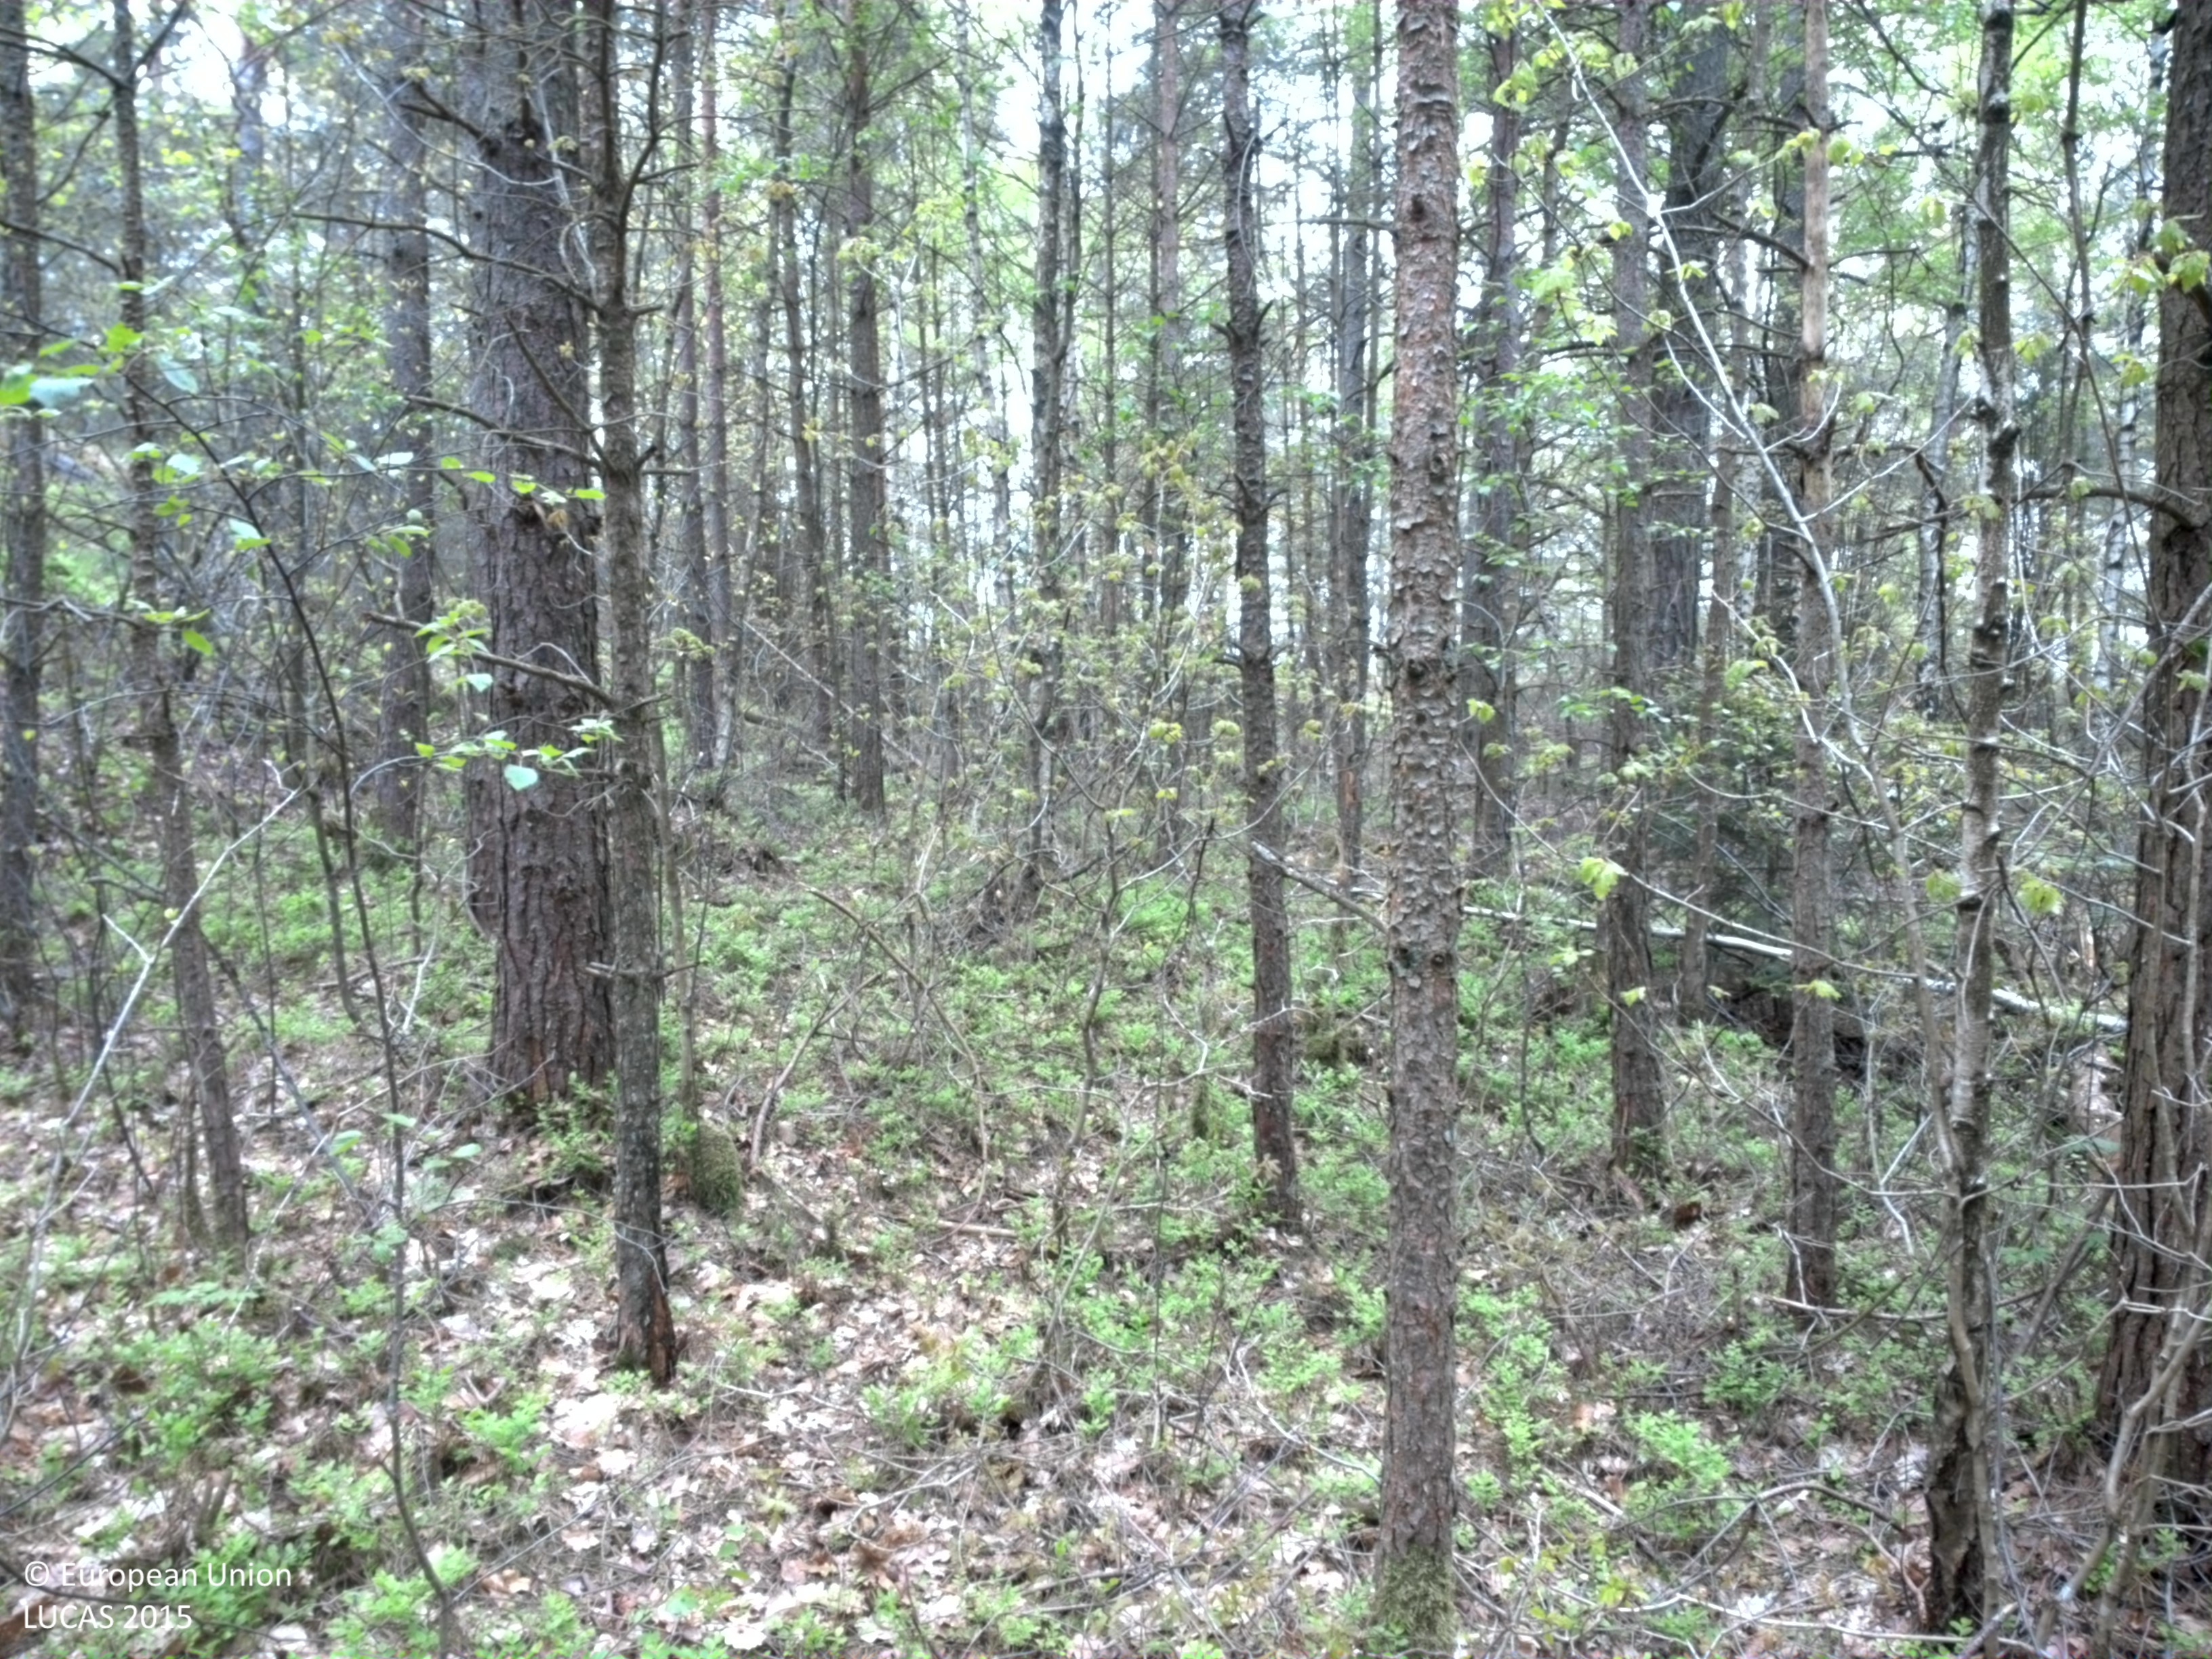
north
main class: Woodland
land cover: Pine dominated mixed woodland
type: boreal forest
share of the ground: > 75 %
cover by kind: coniferous forest trees 55 %, broadleaved forest trees 25 %, shrubs 15 %, herbaceous plants 5 %
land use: Forestry
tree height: > 5 m
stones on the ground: < 10 %
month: May
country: SE
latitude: 57.8093
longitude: 11.9657
